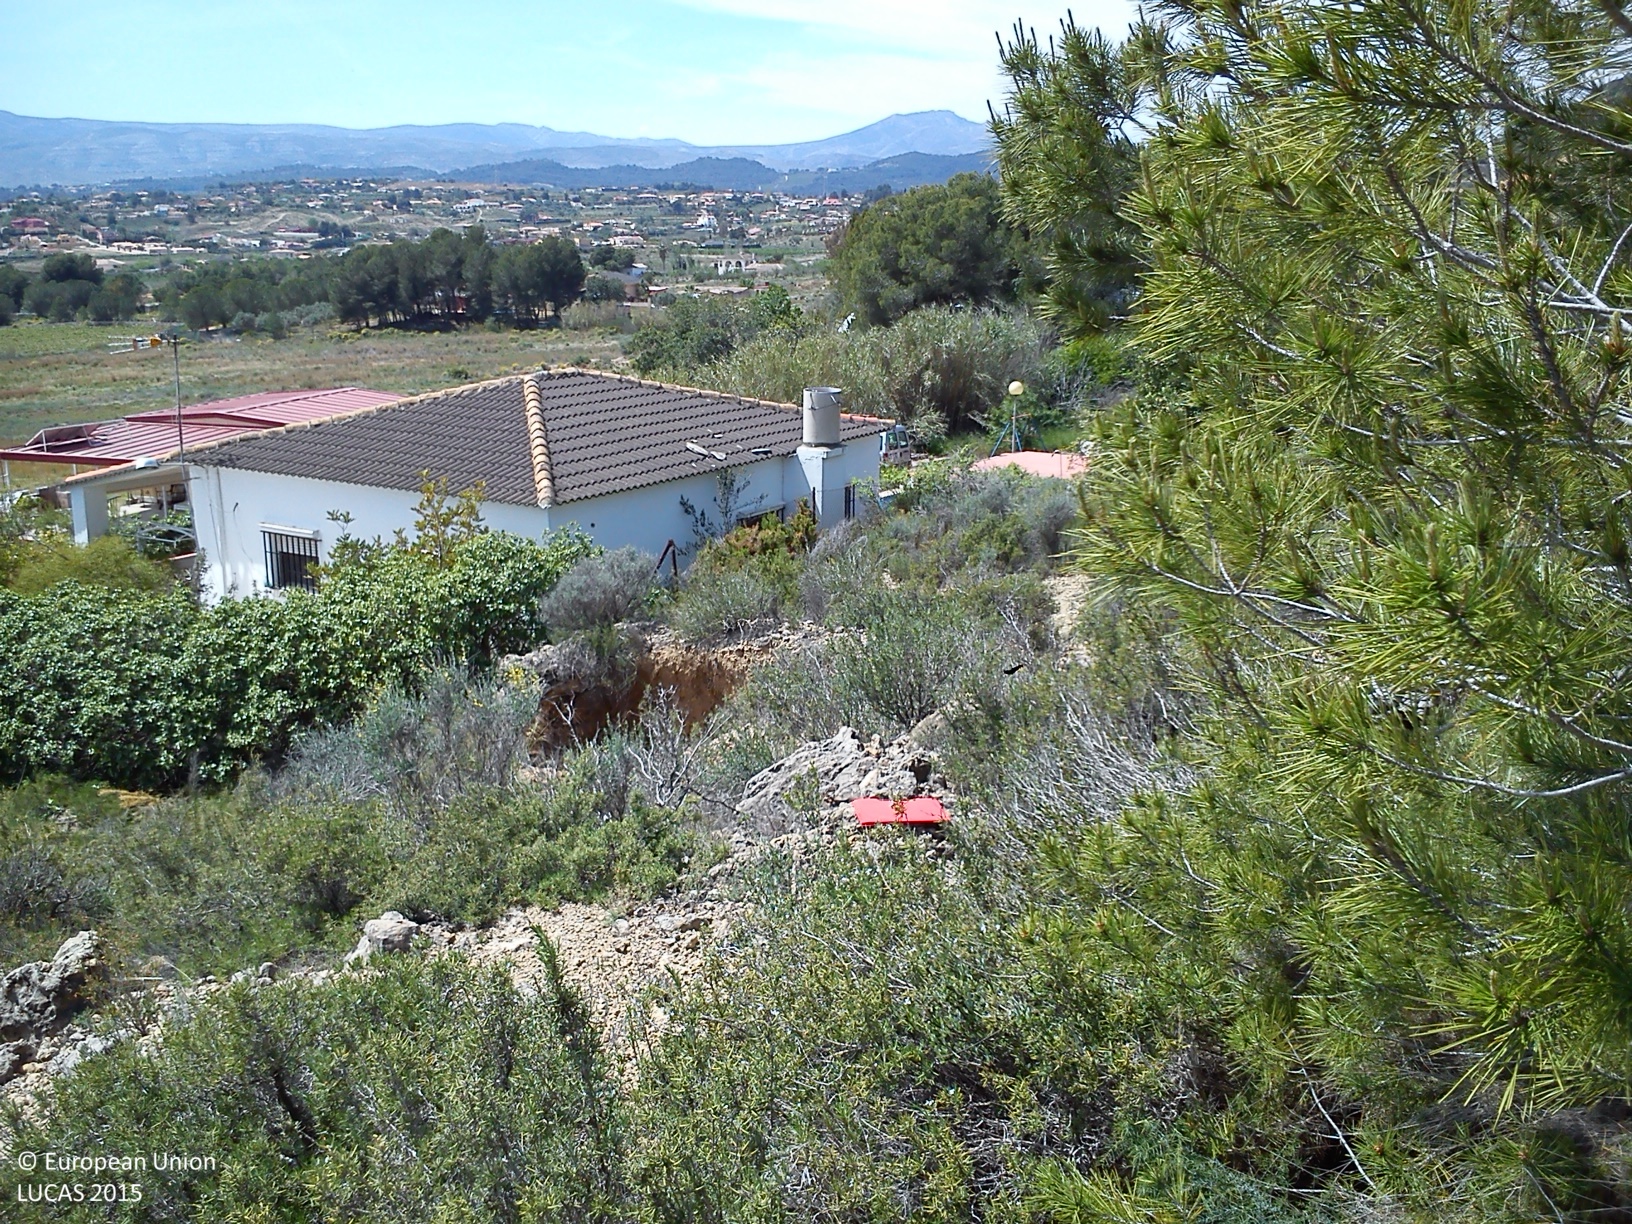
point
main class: Shrubland
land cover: Shrubland with sparse tree cover
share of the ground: > 75 %
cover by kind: shrubs 70 %, herbaceous plants 15 %, consolidated bare surface 10 %, coniferous forest trees 5 %
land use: Semi-natural and natural areas not in use
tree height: < 5 m
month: April
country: ES
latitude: 39.3613
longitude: -0.6166
